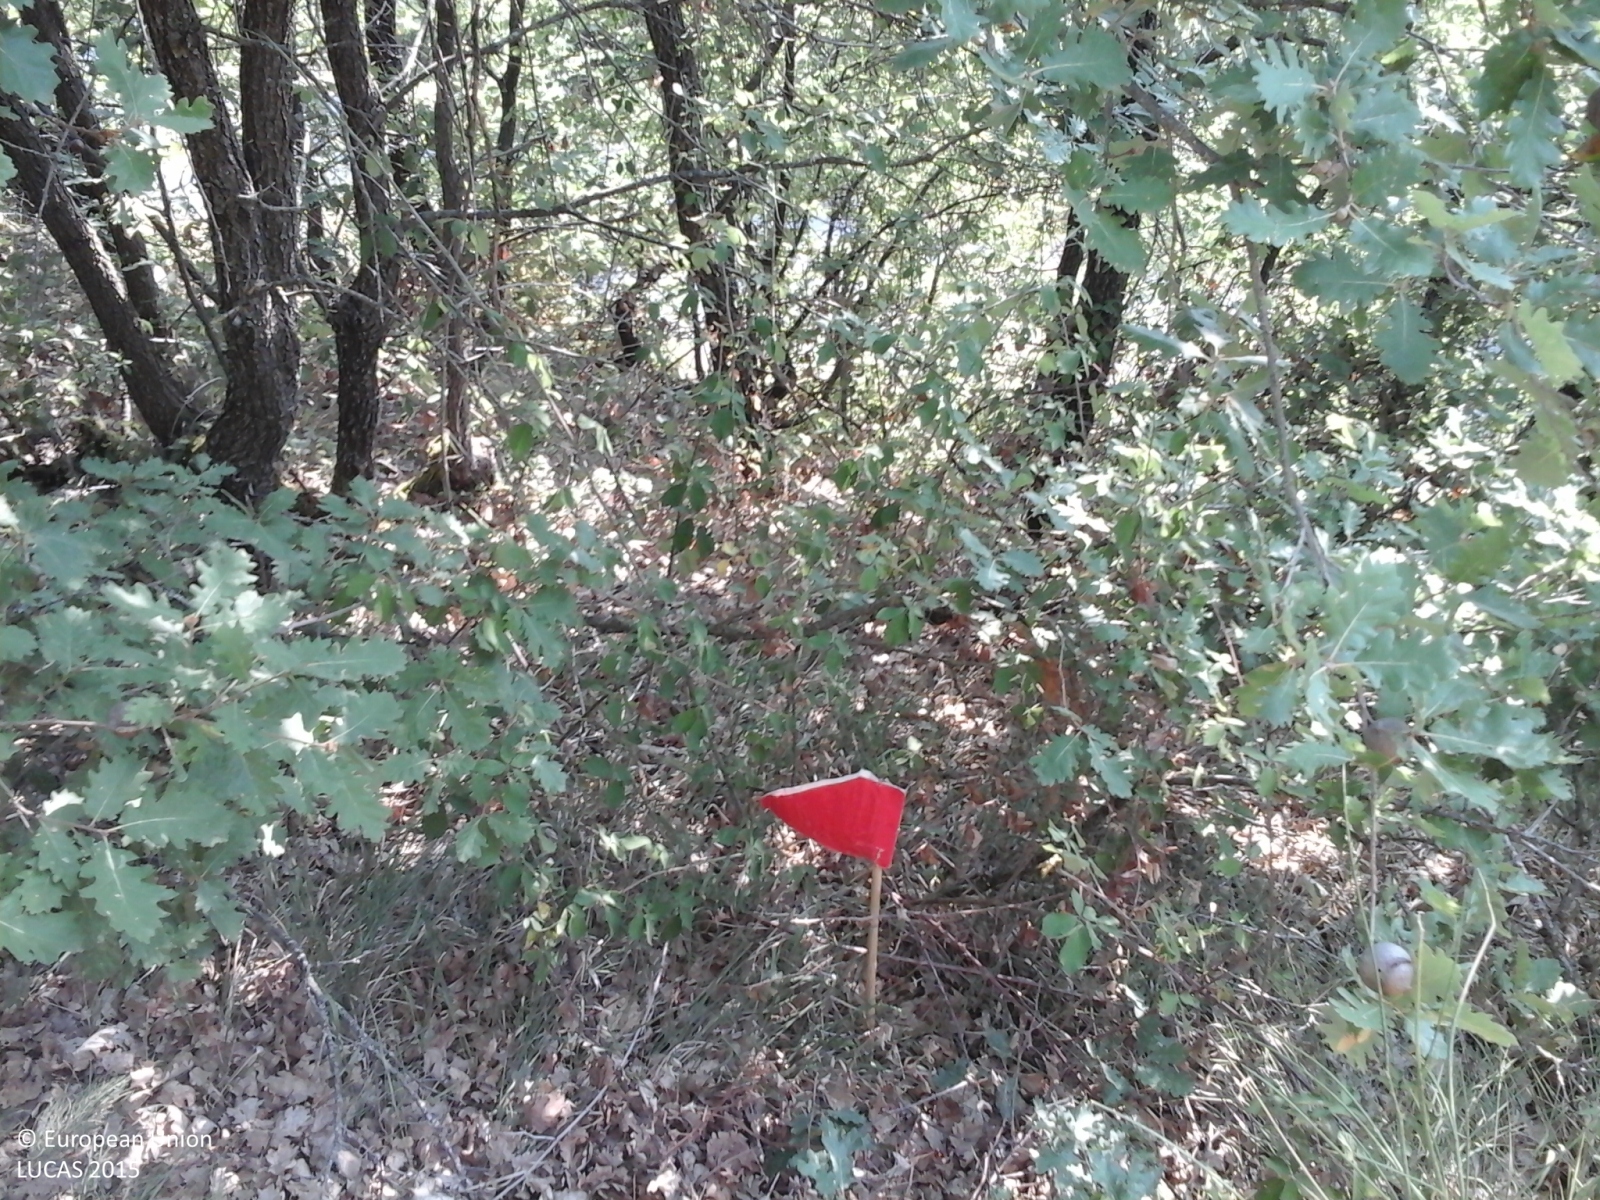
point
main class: Woodland
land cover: Broadleaved woodland
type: thermophilous deciduous forest
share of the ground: > 75 %
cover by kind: broadleaved forest trees 85 %, shrubs 10 %, herbaceous plants 5 %
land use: Semi-natural and natural areas not in use
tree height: > 5 m
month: August
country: IT
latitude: 41.5341
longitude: 14.2396
